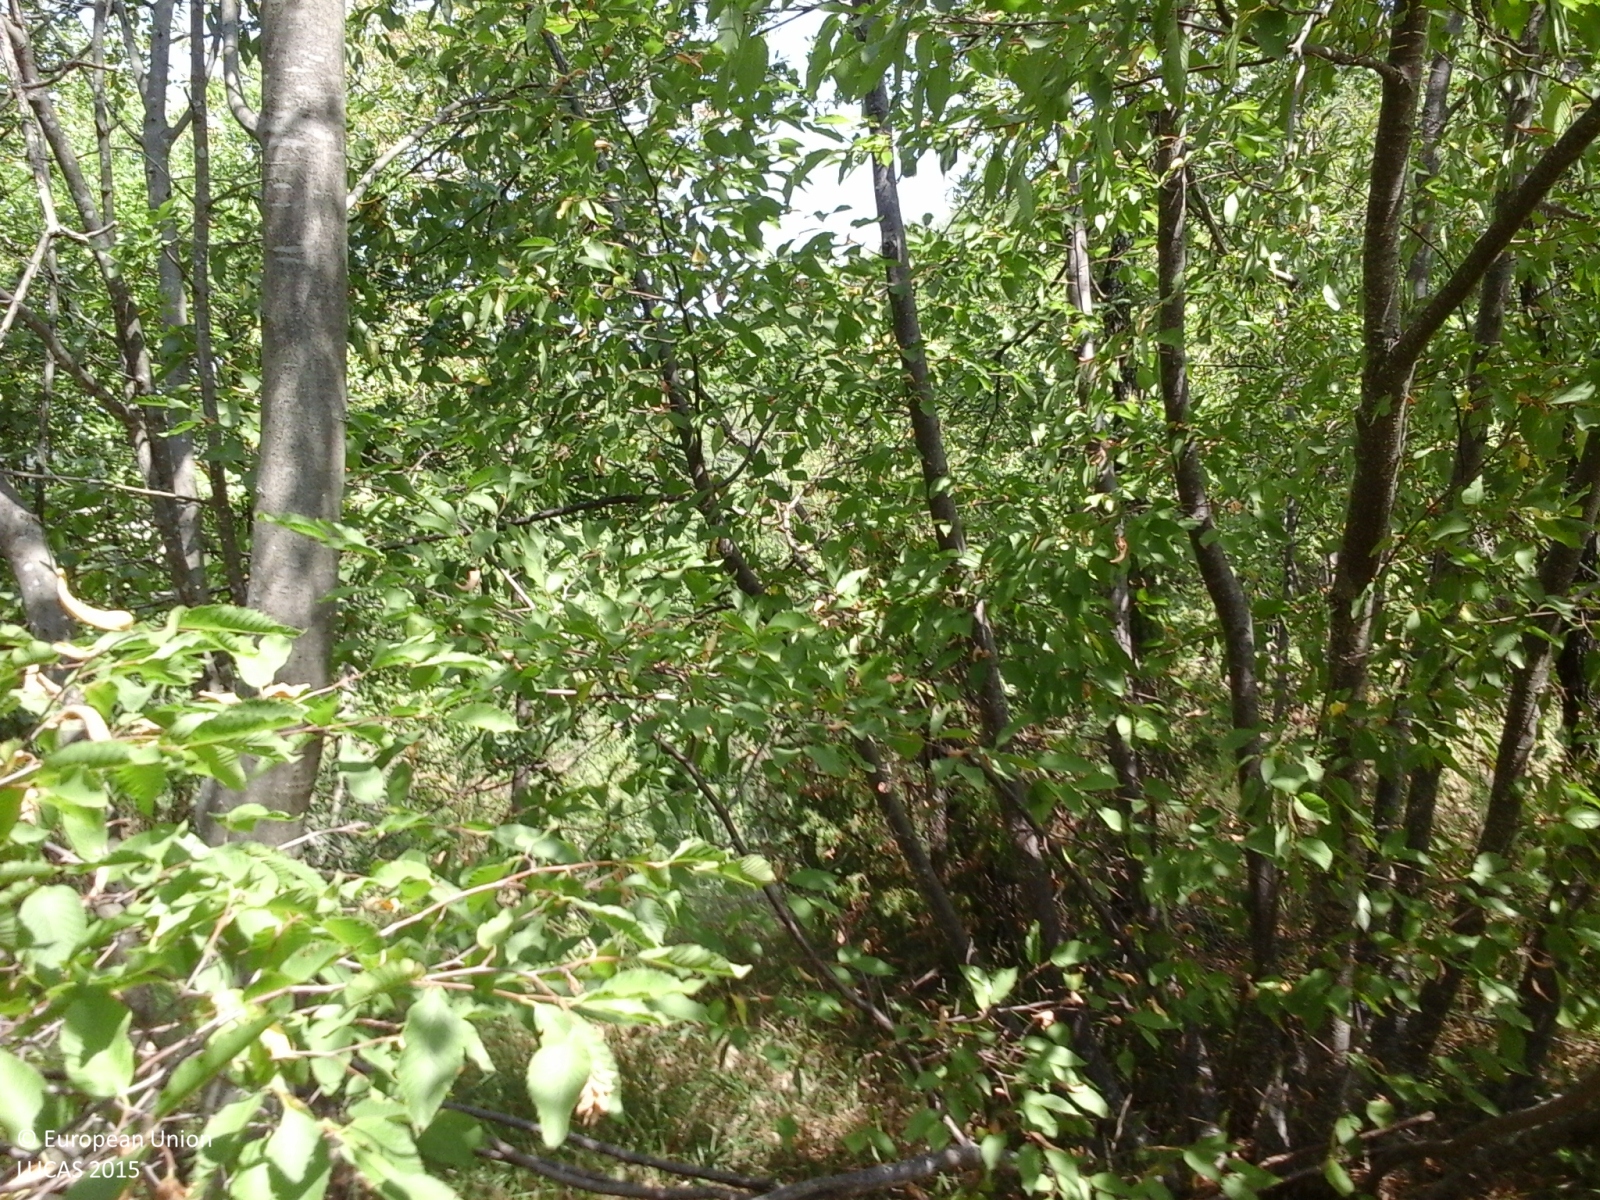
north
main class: Woodland
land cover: Broadleaved woodland
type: thermophilous deciduous forest
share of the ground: > 75 %
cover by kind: broadleaved forest trees 100 %
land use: Forestry
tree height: > 5 m
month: August
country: IT
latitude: 43.7053
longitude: 12.5624
